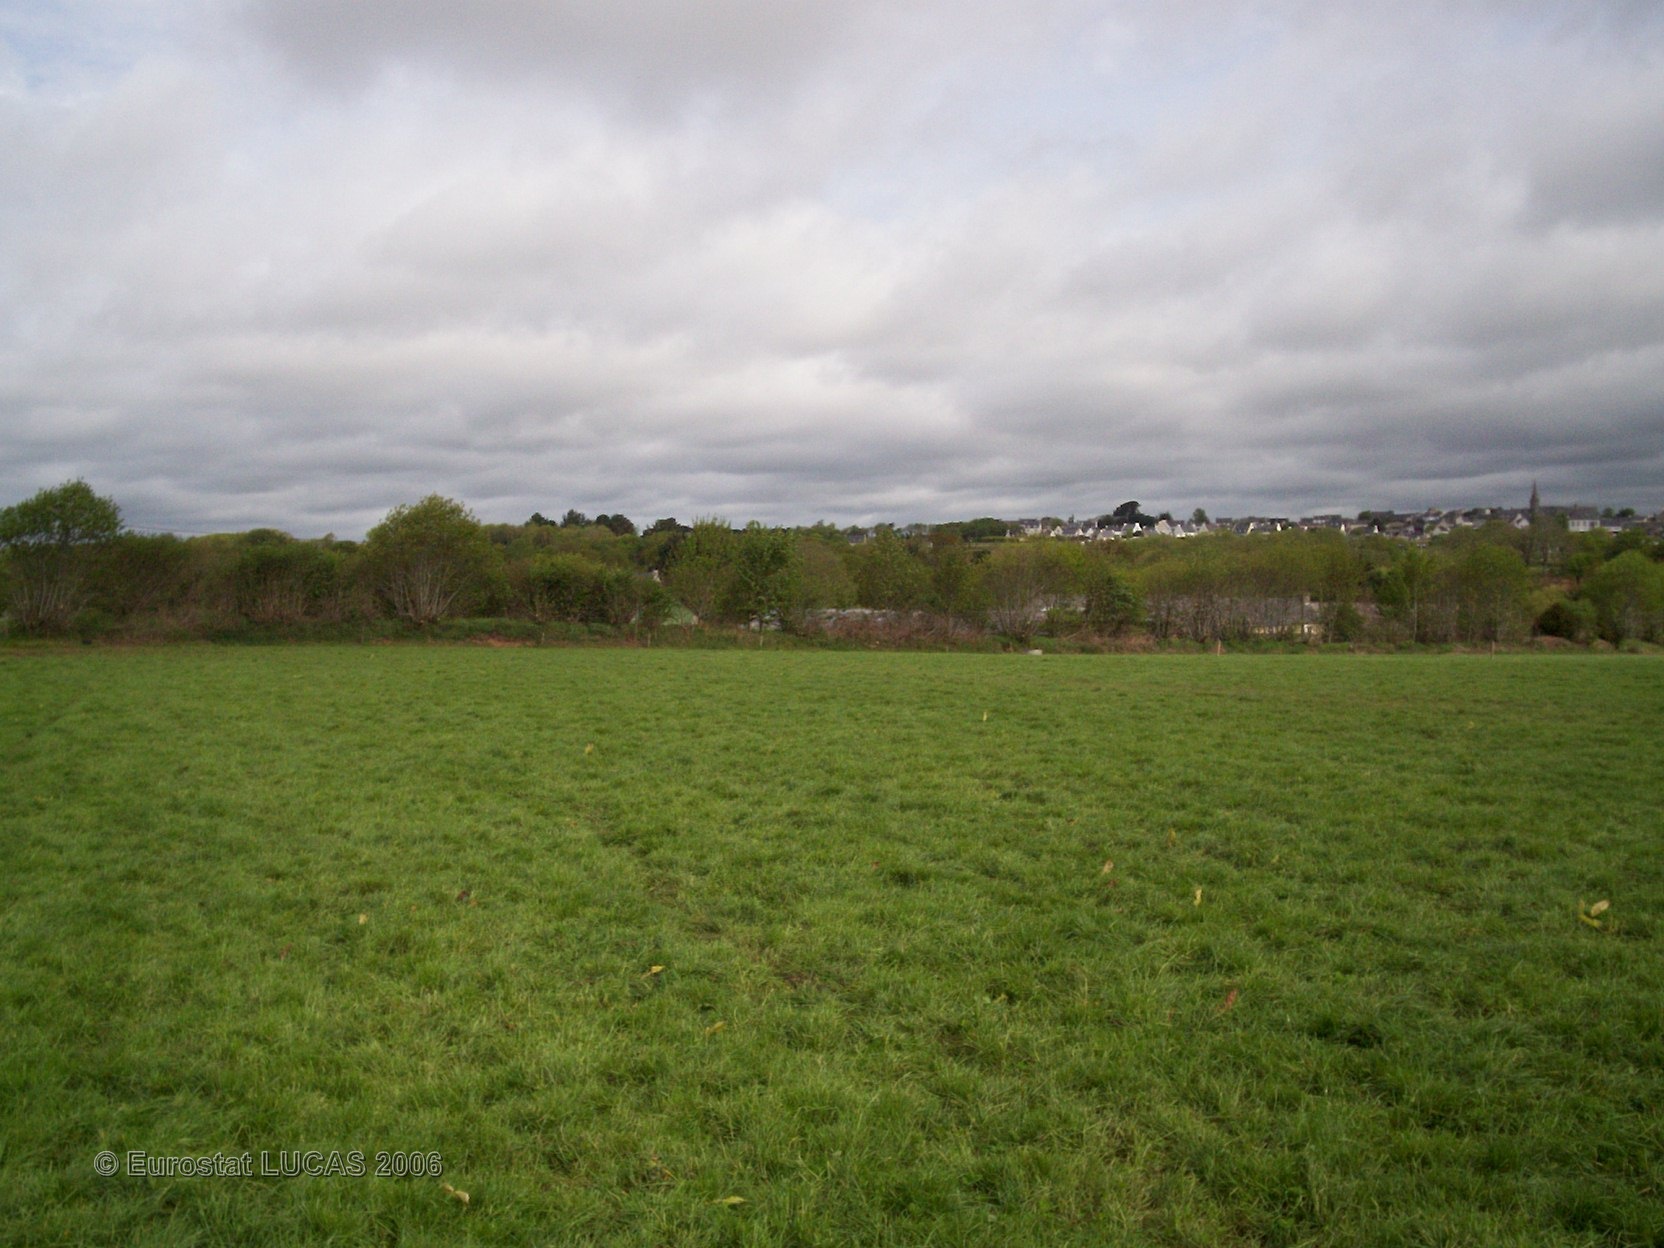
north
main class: Grassland
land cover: Grassland without tree/shrub cover
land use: Agriculture (excluding fallow land and kitchen gardens)
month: May
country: FR
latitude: 48.5110
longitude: -3.7145
